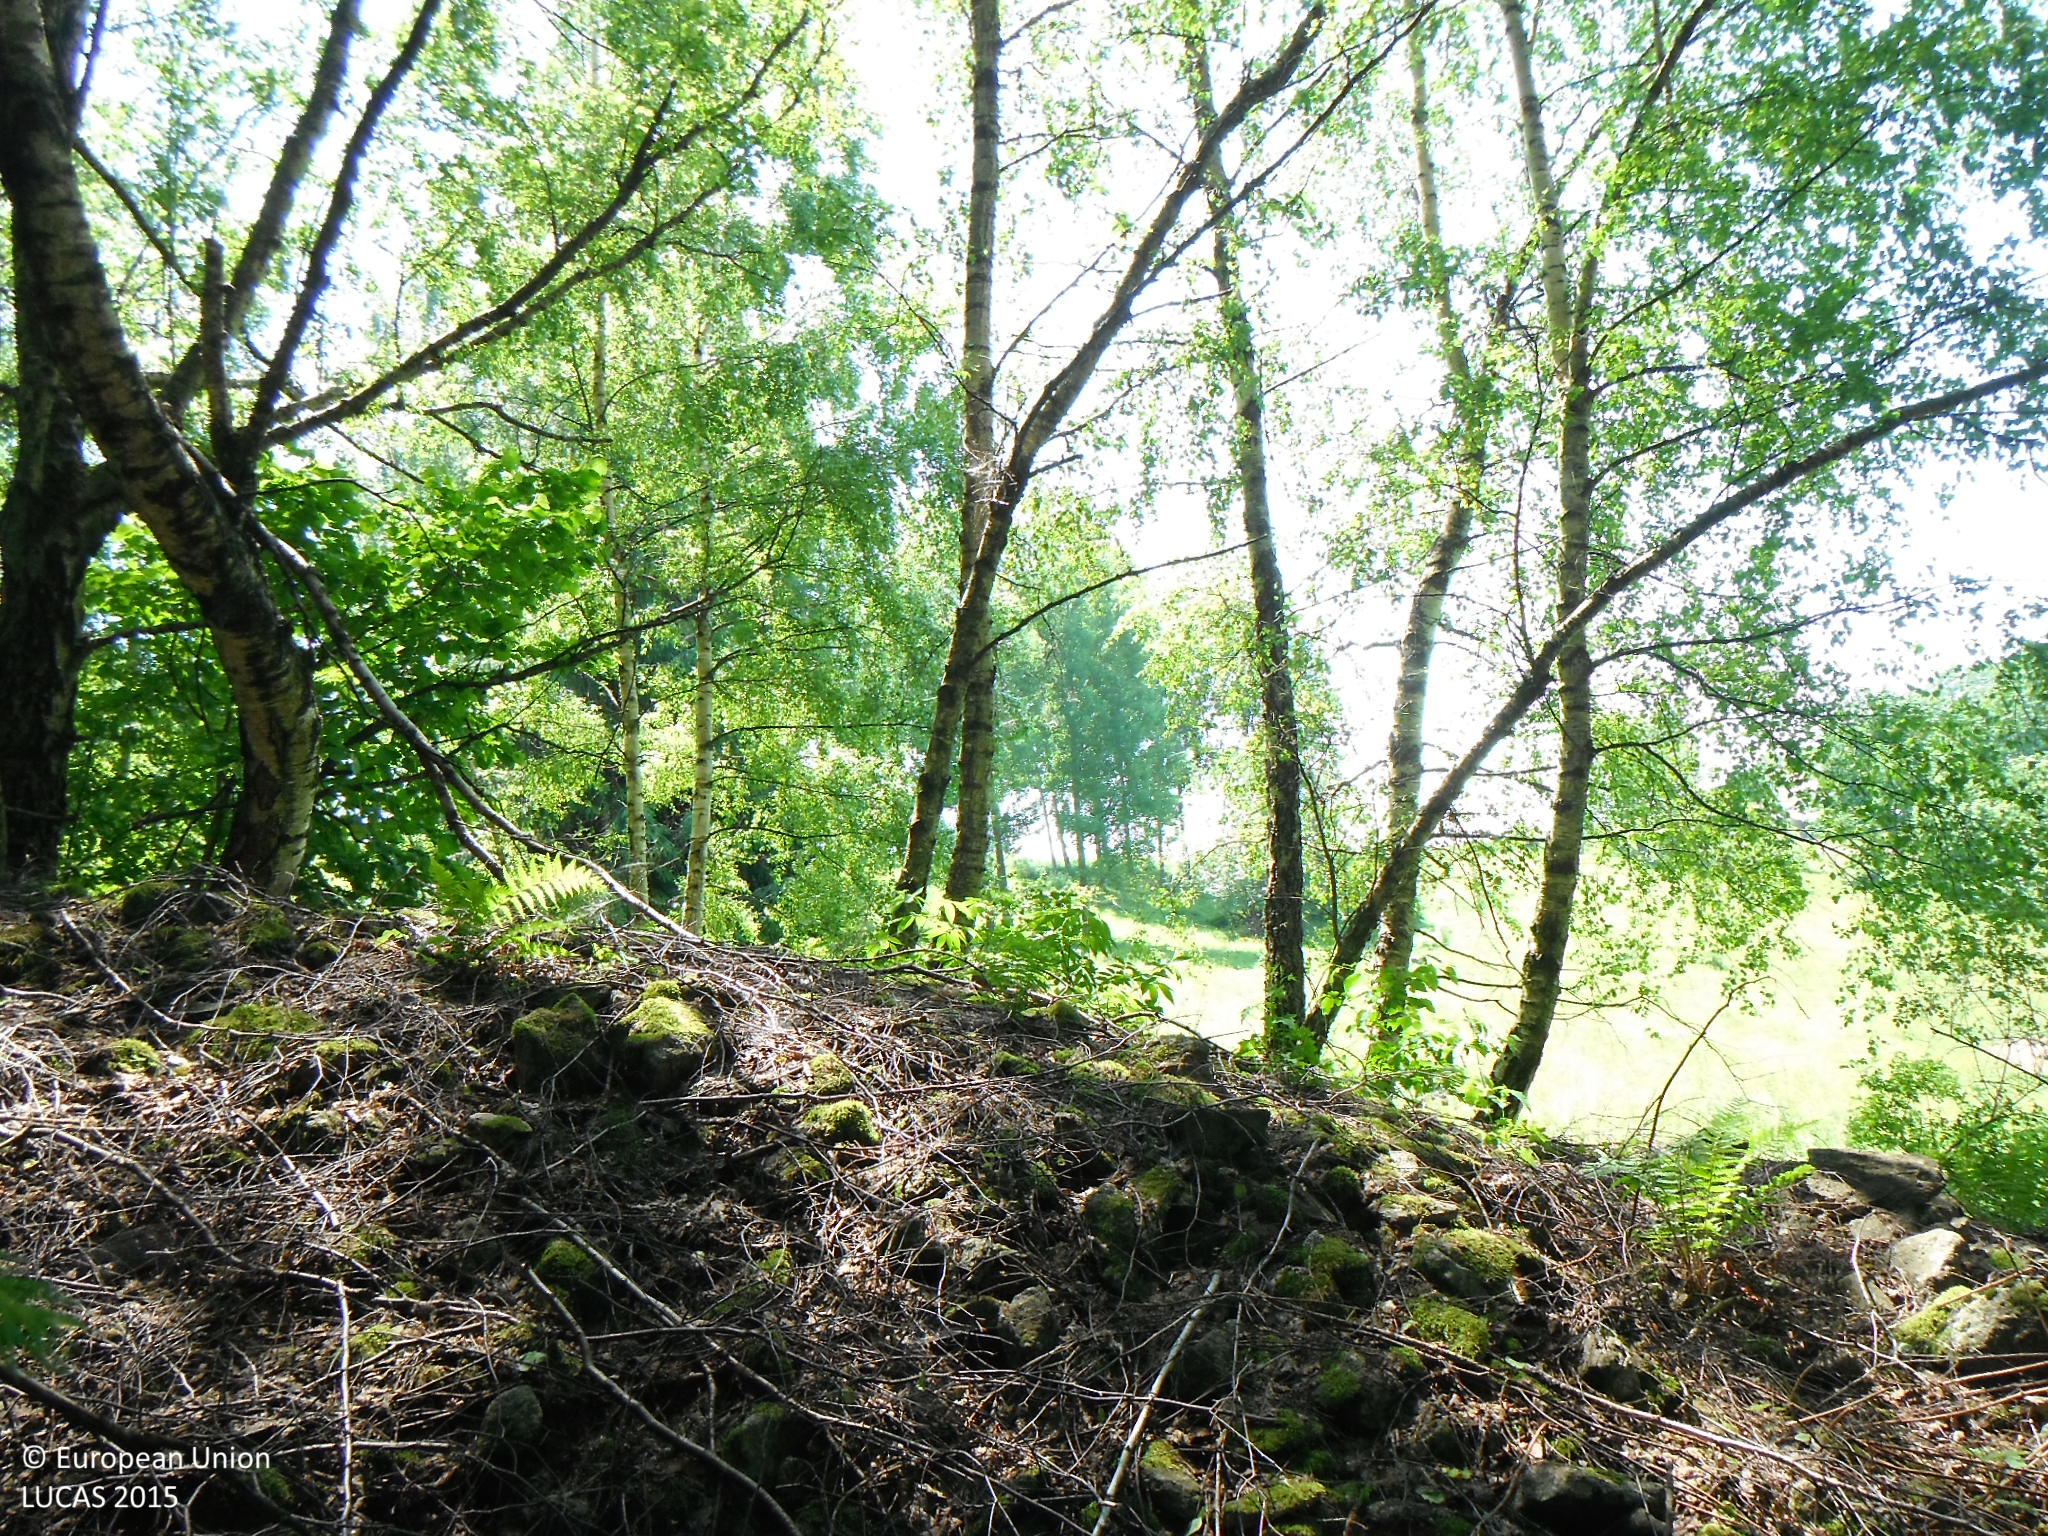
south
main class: Woodland
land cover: Spruce dominated coniferous woodland
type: alpine coniferous forest
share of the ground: > 75 %
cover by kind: coniferous forest trees 75 %, broadleaved forest trees 10 %, herbaceous plants 10 %, shrubs 5 %
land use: Forestry
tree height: > 5 m
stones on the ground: < 10 %
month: June
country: SK
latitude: 48.5678
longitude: 19.7712
